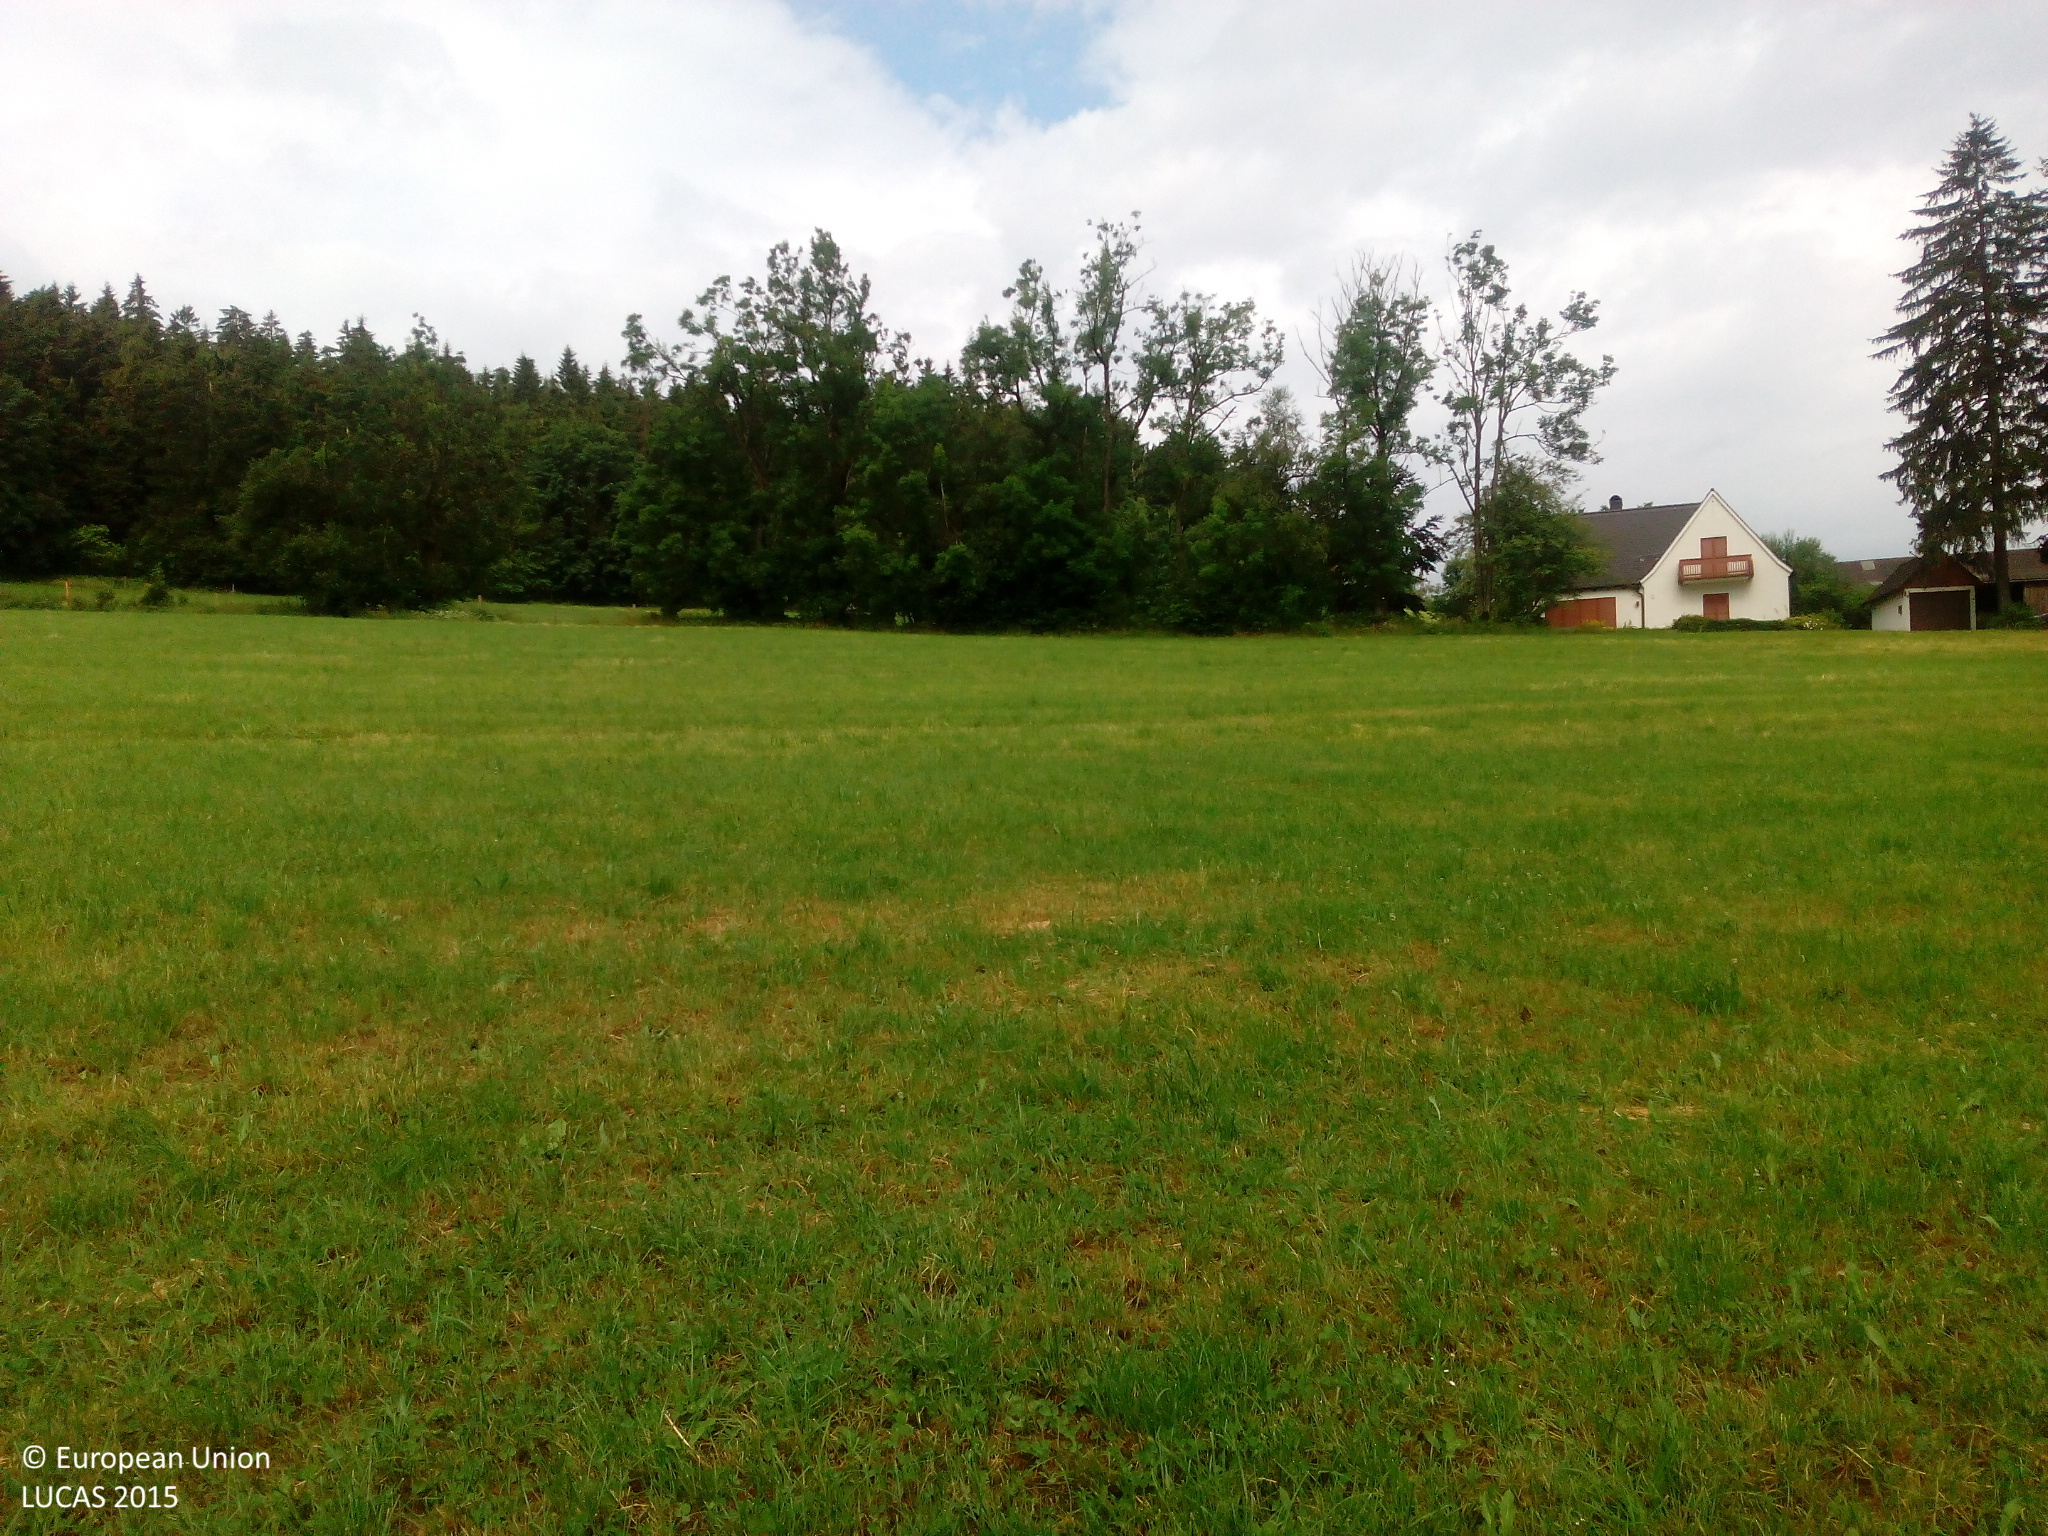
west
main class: Grassland
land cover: Grassland without tree/shrub cover
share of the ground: > 75 %
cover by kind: herbaceous plants 95 %, unconsolidated bare surface 5 %
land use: Agriculture (excluding fallow land and kitchen gardens)
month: July
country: DE
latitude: 49.6739
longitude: 12.3692
